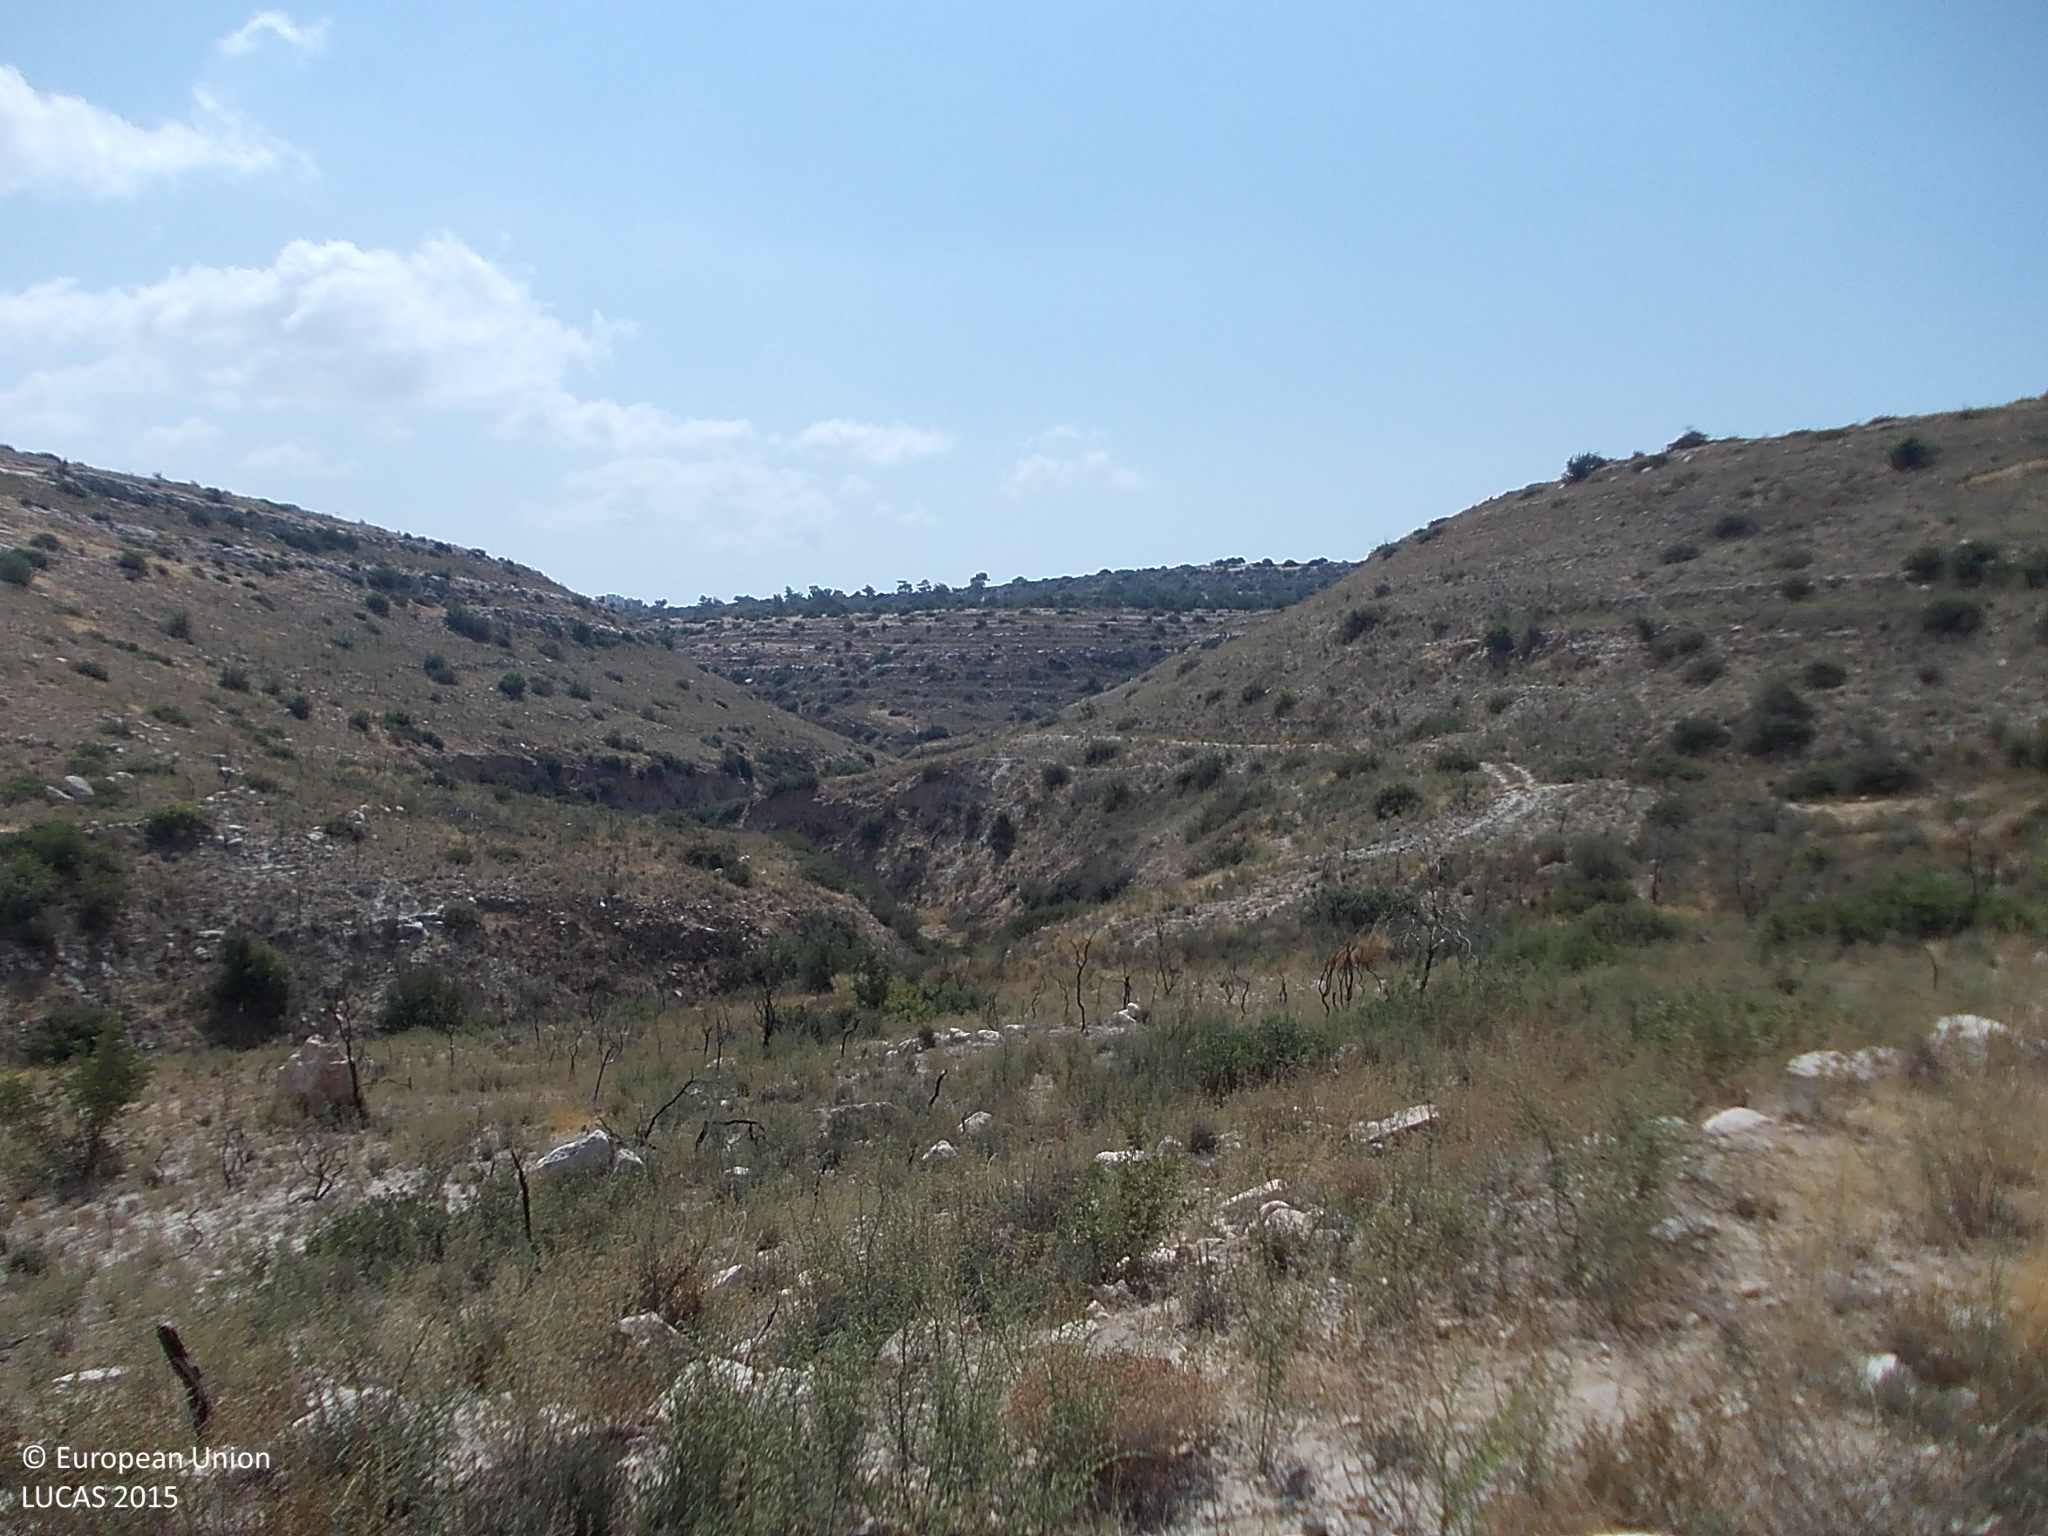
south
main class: Shrubland
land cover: Shrubland without tree cover
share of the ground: 25 - 50 %
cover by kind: shrubs 45 %, herbaceous plants 30 %, unconsolidated bare surface 20 %, consolidated bare surface 5 %
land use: Semi-natural and natural areas not in use
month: September
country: CY
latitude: 34.7118
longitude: 32.8812
